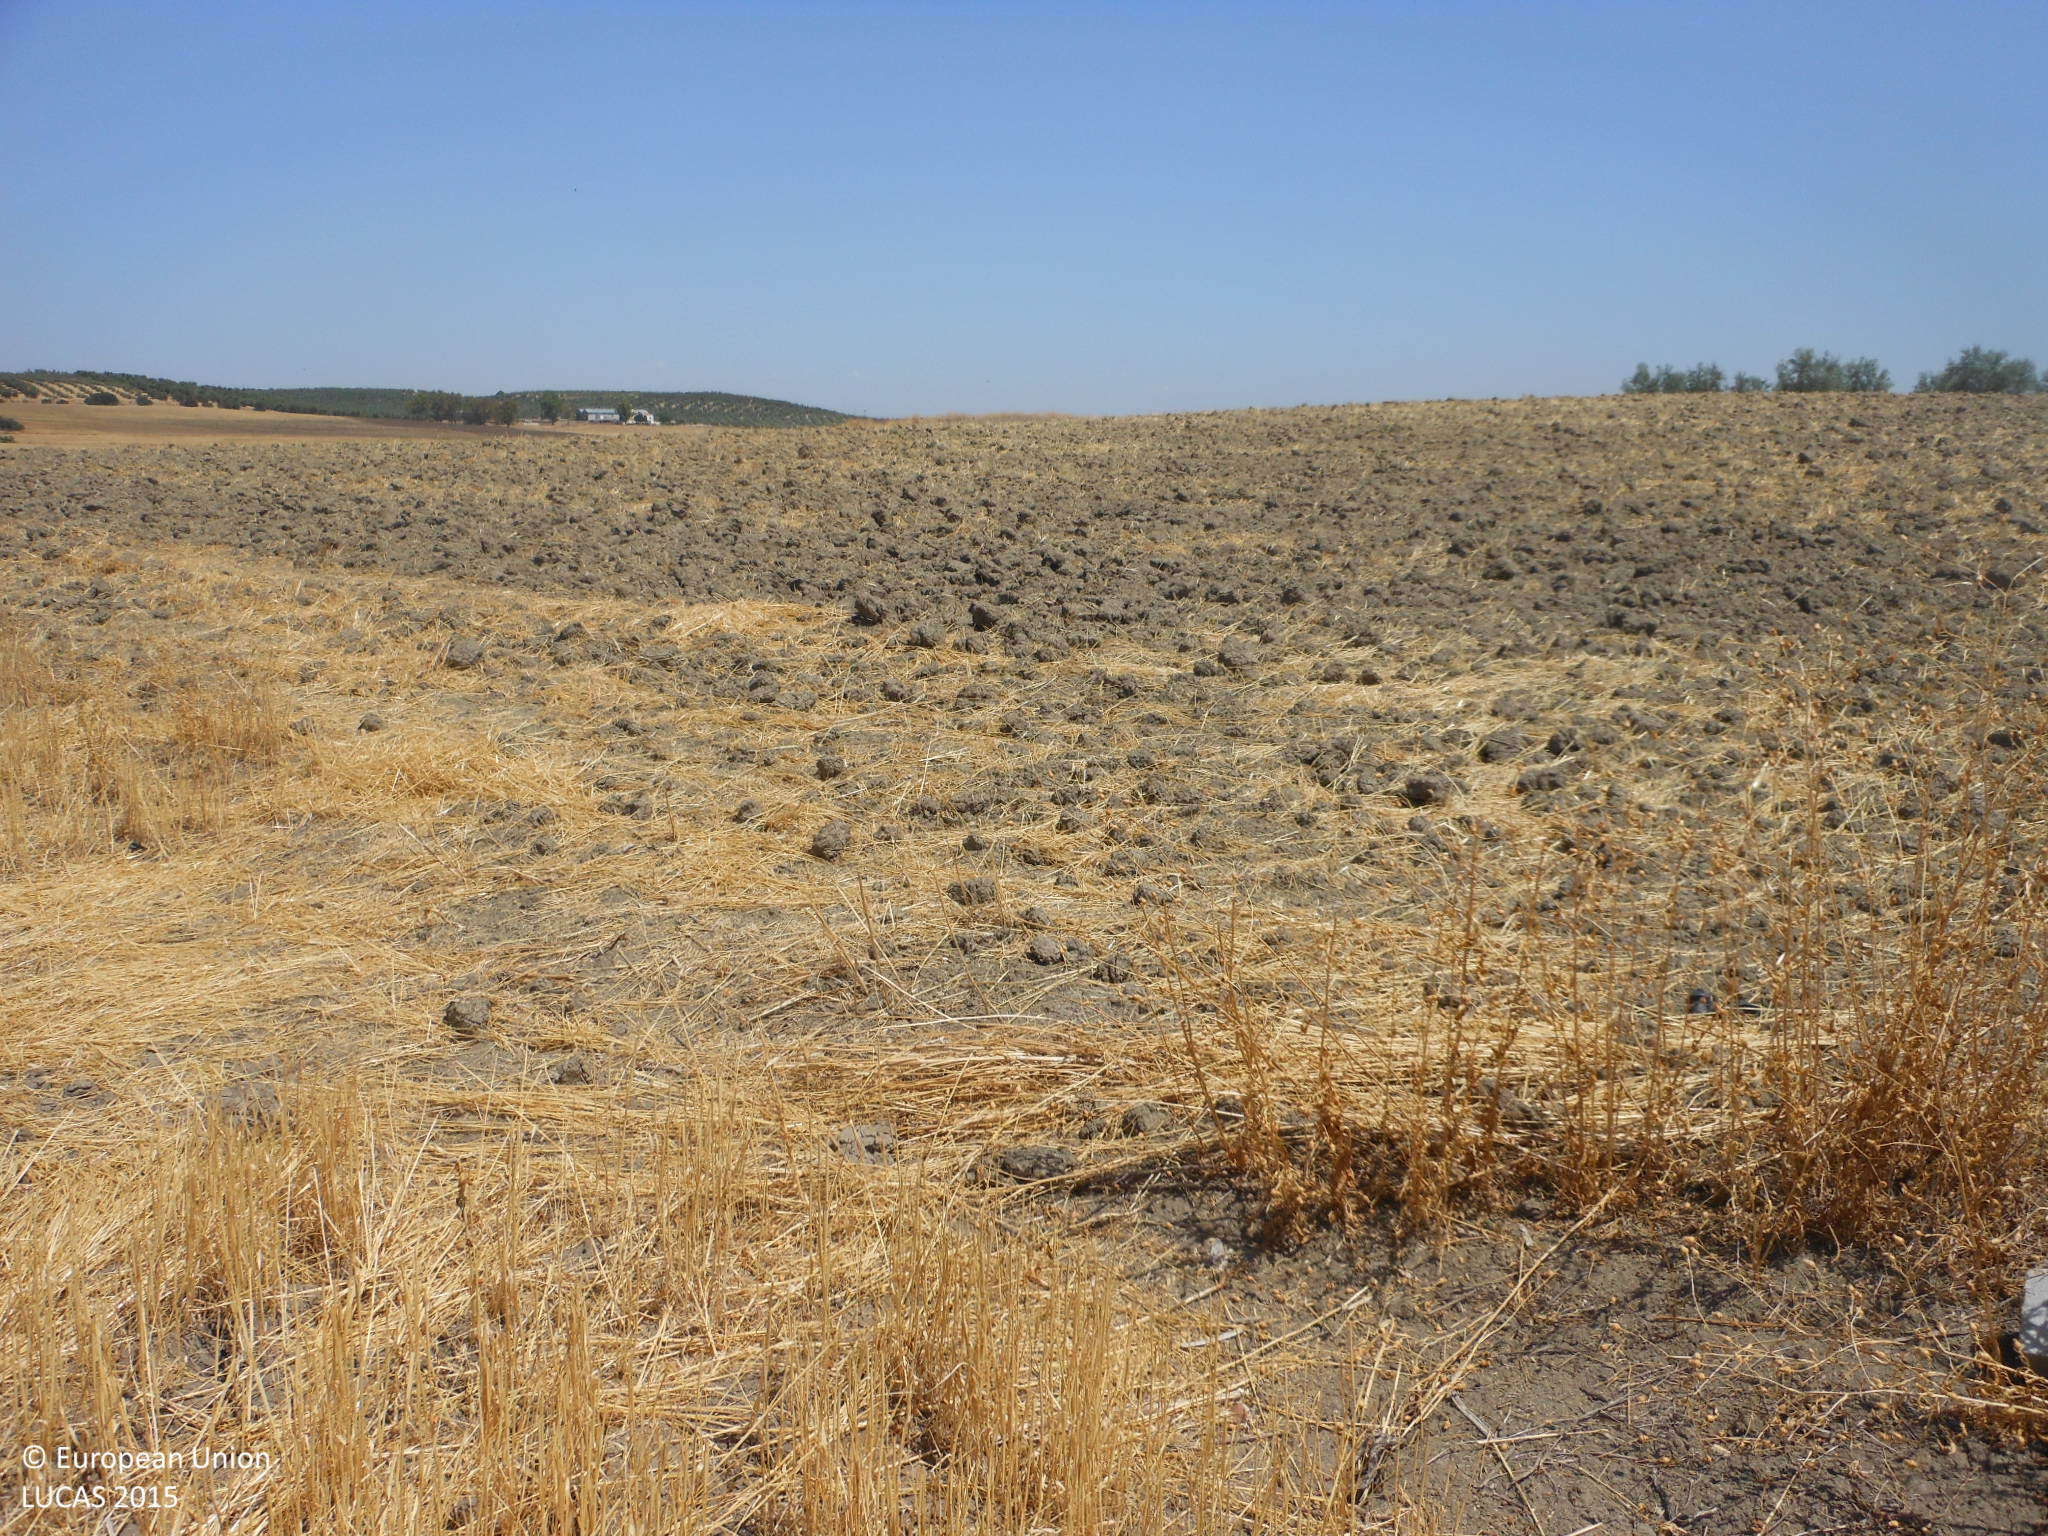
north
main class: Cropland
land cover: Common wheat
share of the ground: < 10 %
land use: Agriculture (excluding fallow land and kitchen gardens)
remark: Harvested field
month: July
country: ES
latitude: 37.2476
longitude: -5.3547
